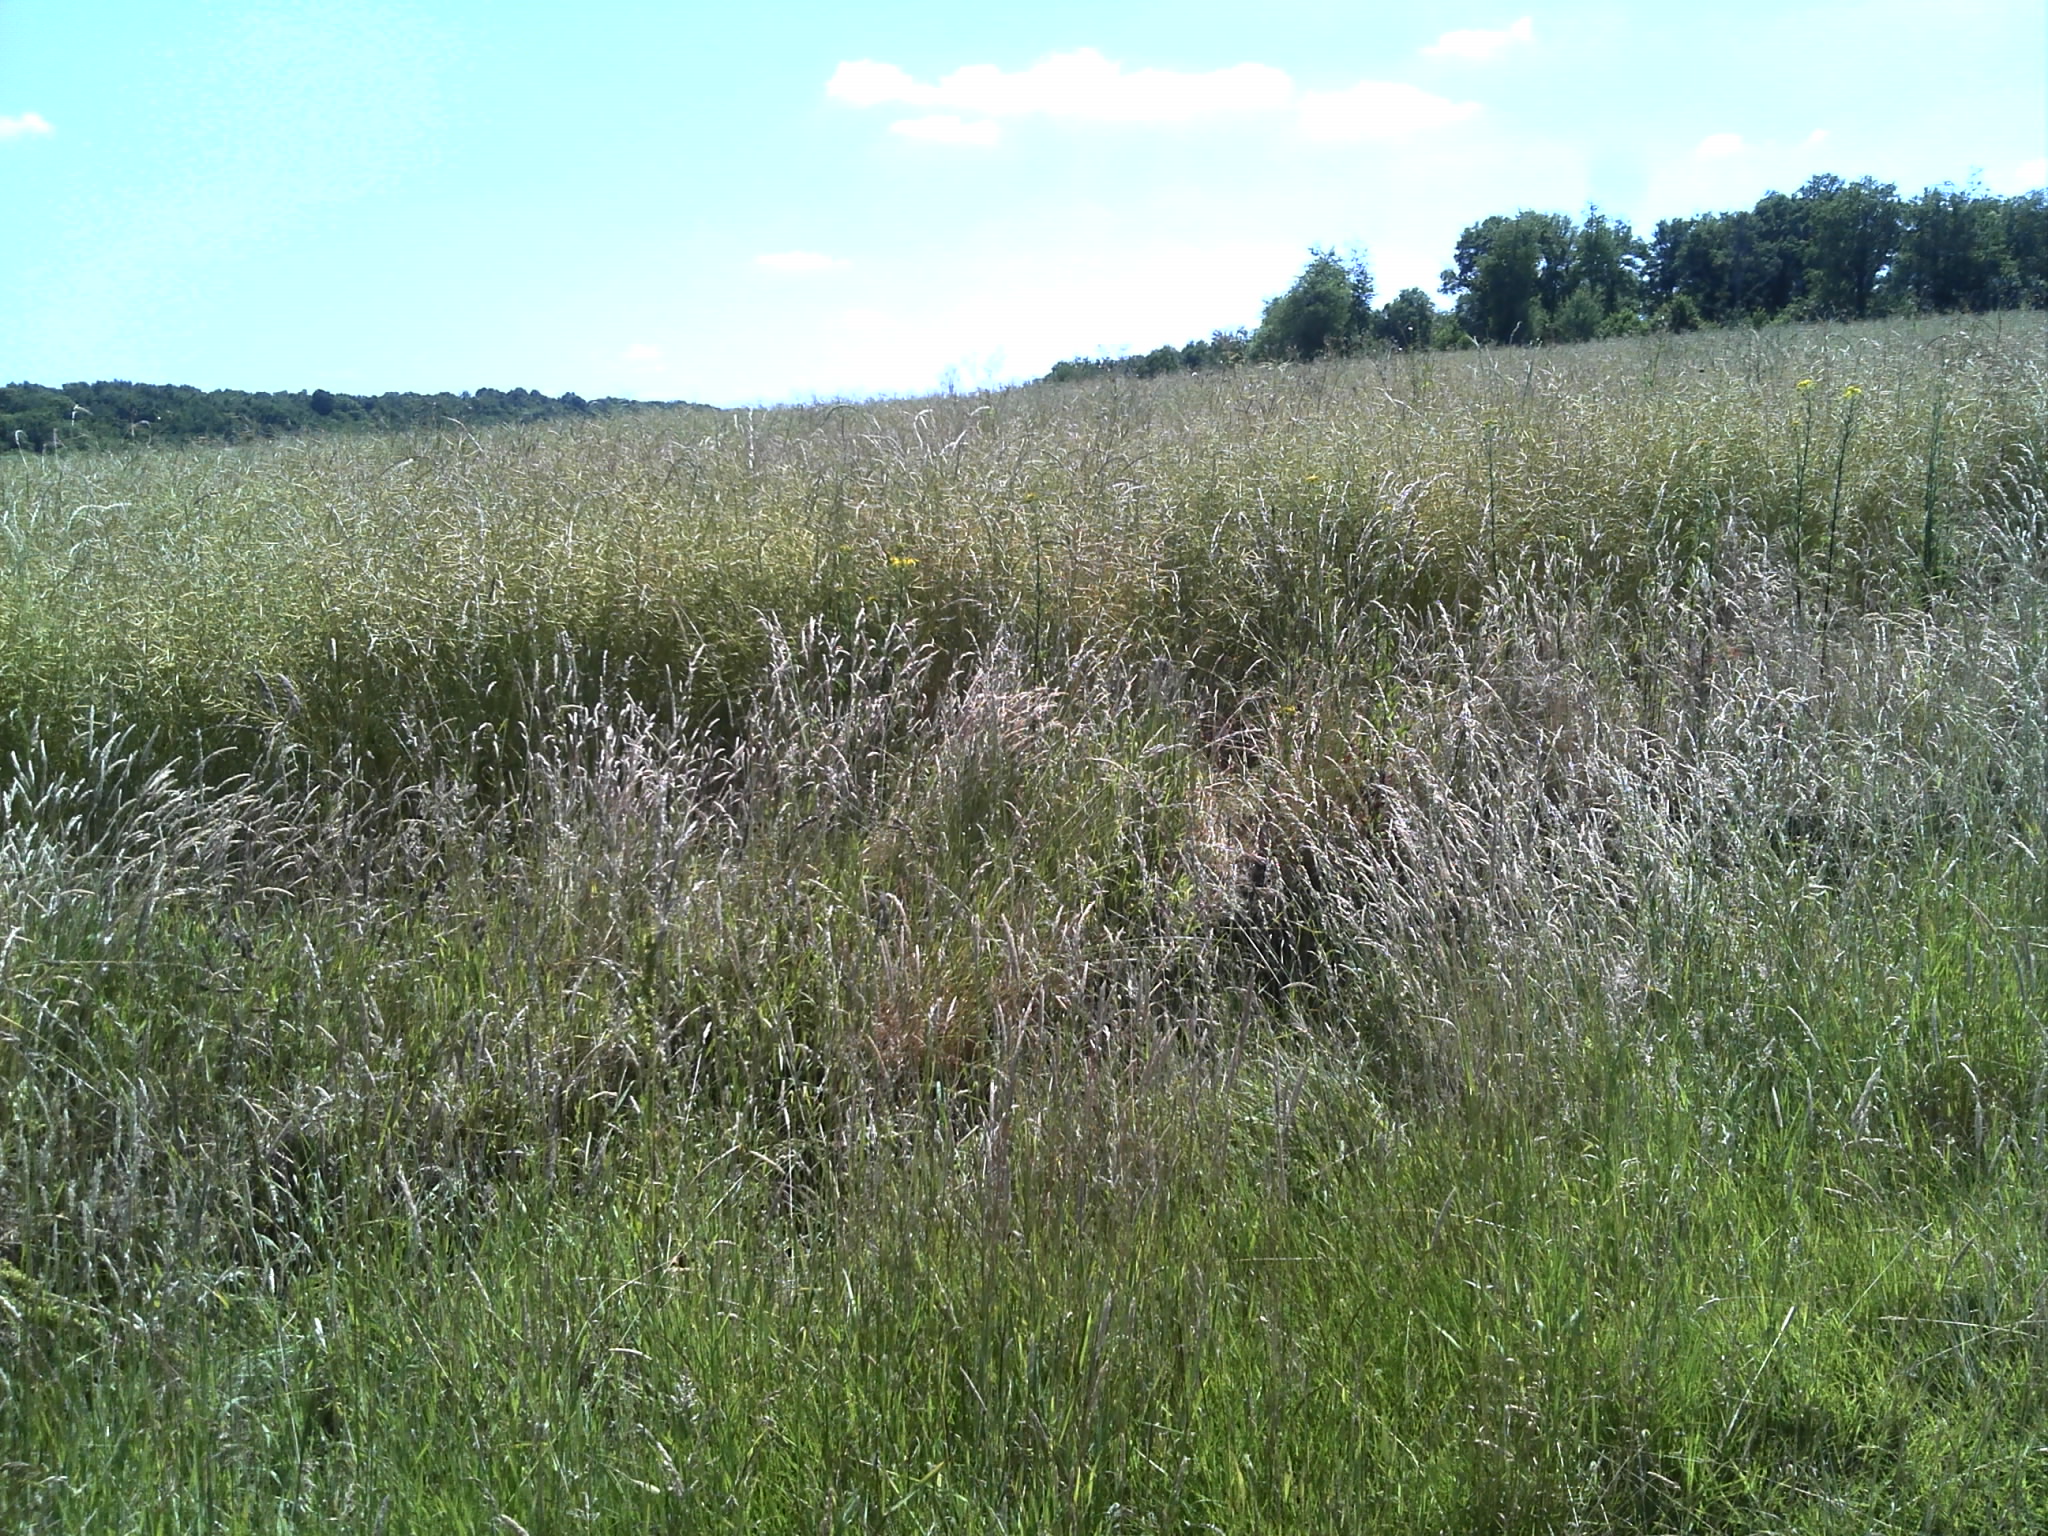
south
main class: Cropland
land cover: Rape and turnip rape
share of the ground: > 75 %
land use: Agriculture (excluding fallow land and kitchen gardens)
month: June
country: FR
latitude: 47.1115
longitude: 1.4342
